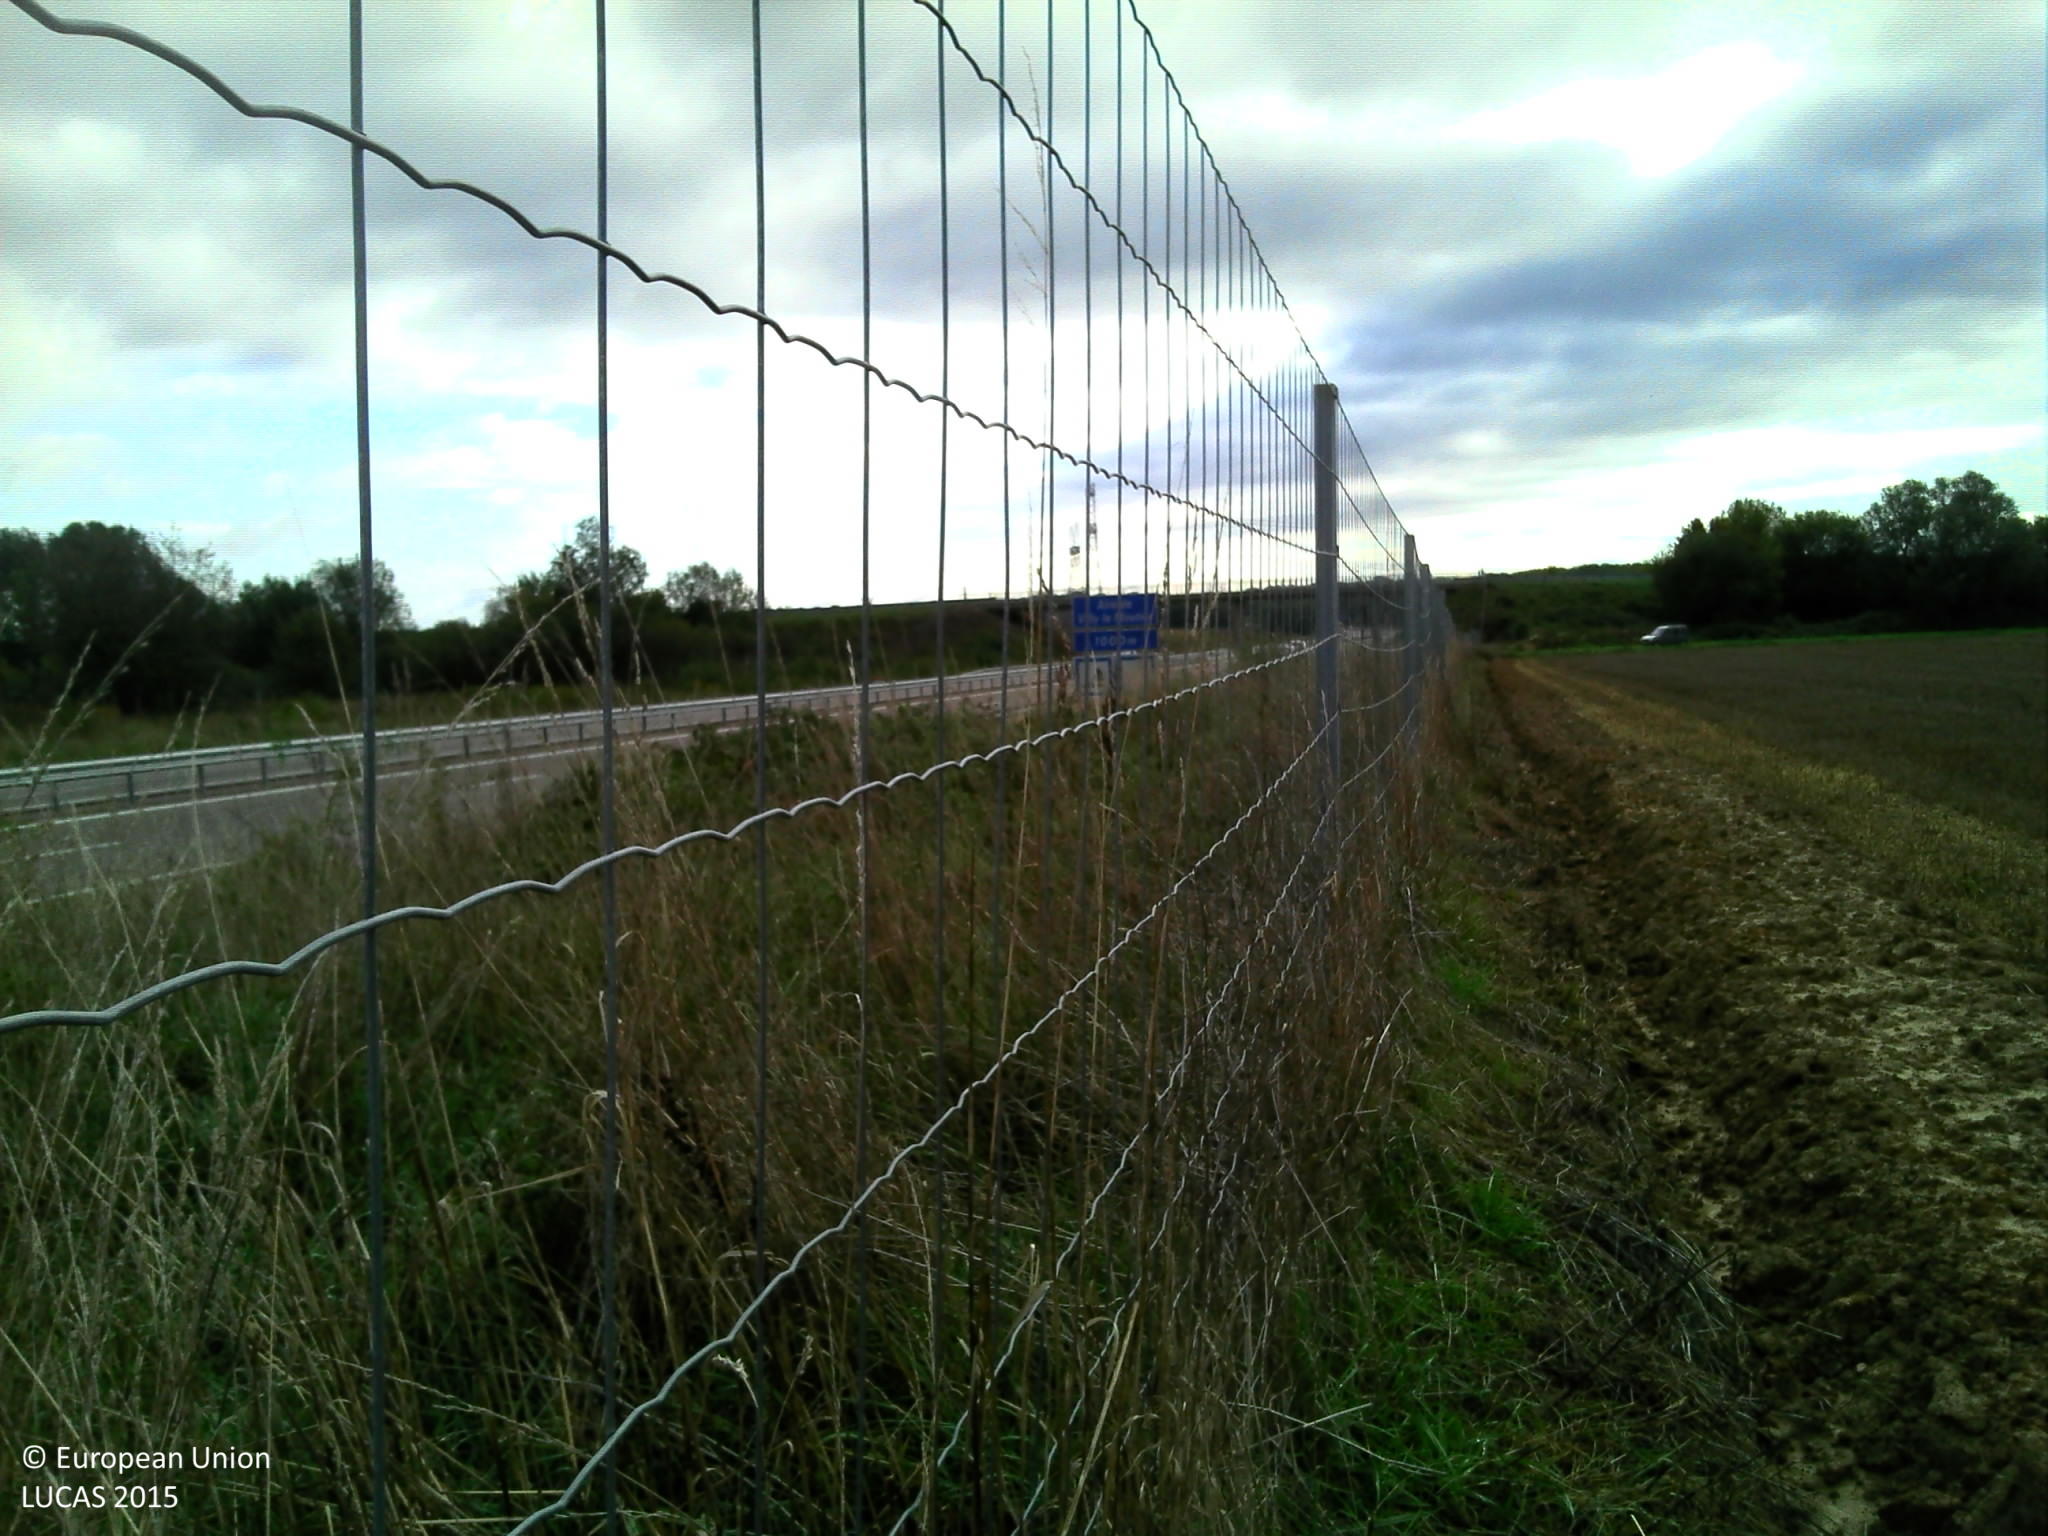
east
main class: Grassland
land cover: Grassland without tree/shrub cover
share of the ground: > 75 %
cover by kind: herbaceous plants 95 %, shrubs 5 %
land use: Road transport
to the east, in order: Grassland without tree/shrub cover; Paved roads, cycling and walking lanes; Grassland without tree/shrub cover
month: September
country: FR
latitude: 47.0455
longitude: 4.9861
